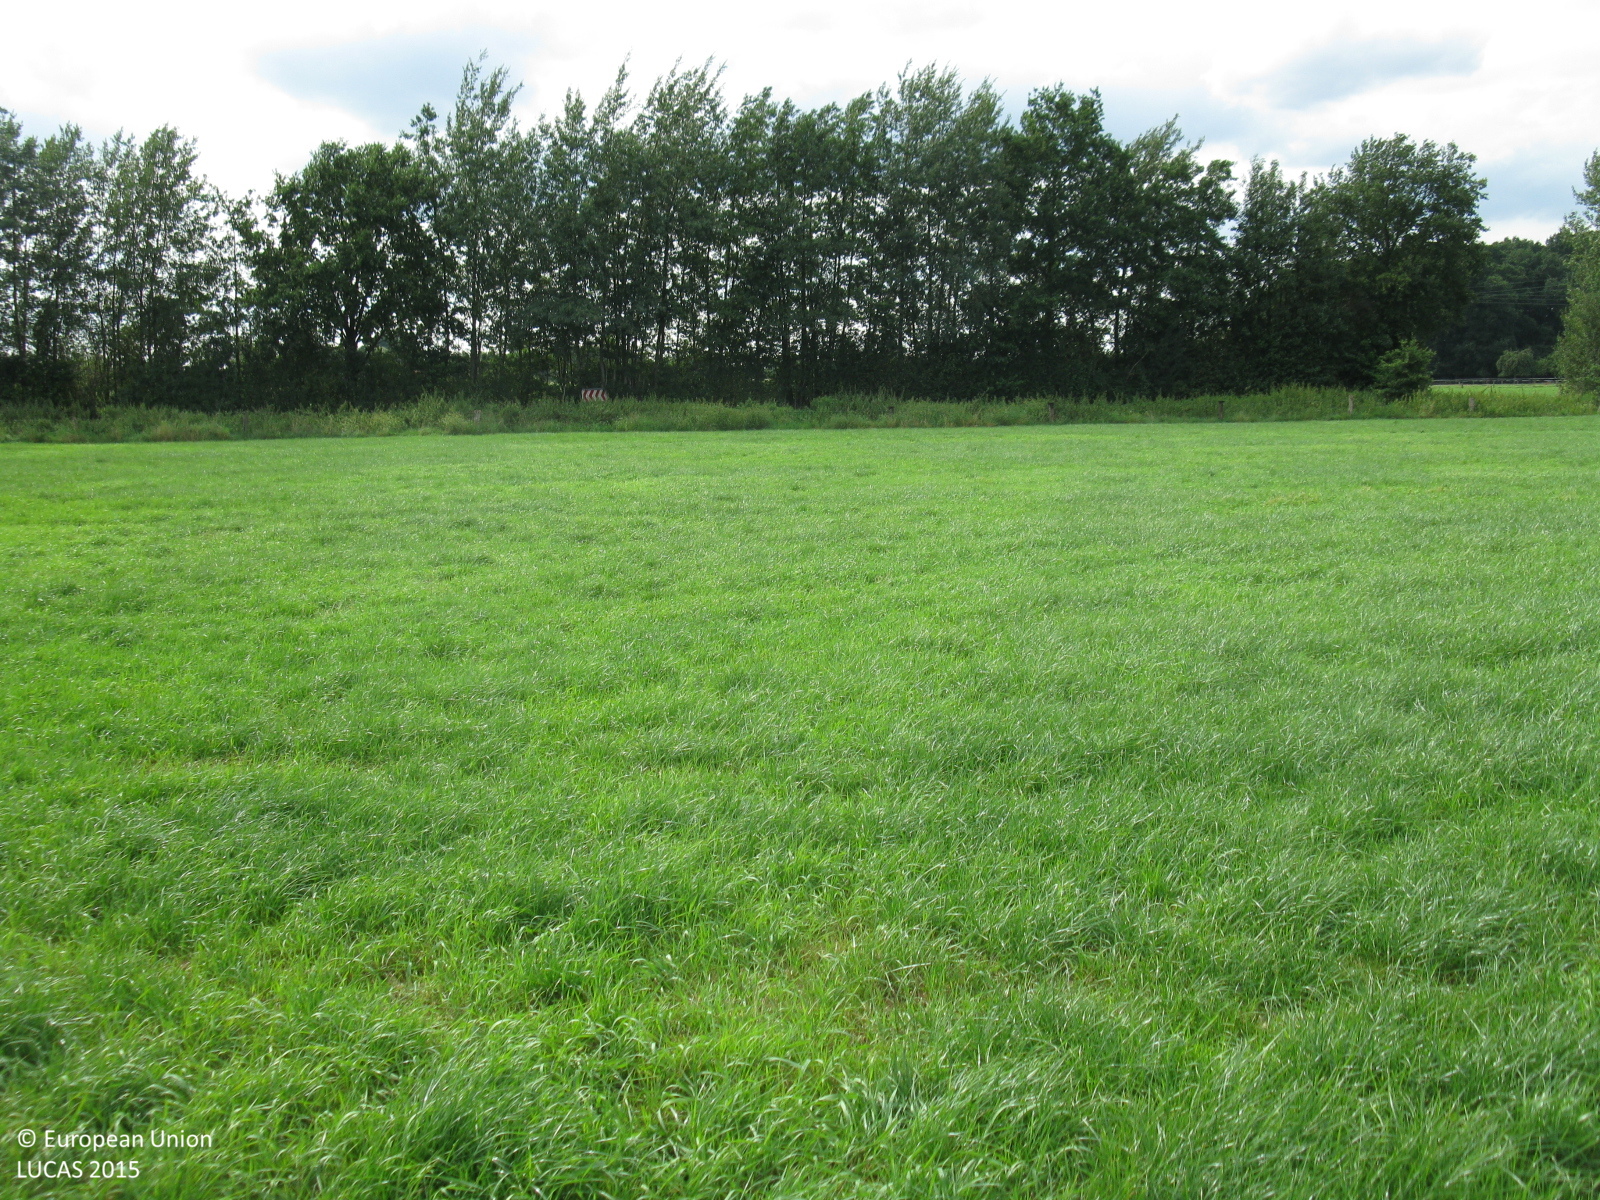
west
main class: Grassland
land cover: Grassland without tree/shrub cover
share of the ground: > 75 %
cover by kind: herbaceous plants 100 %
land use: Agriculture (excluding fallow land and kitchen gardens)
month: August
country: DE
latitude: 51.8164
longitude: 6.9391
